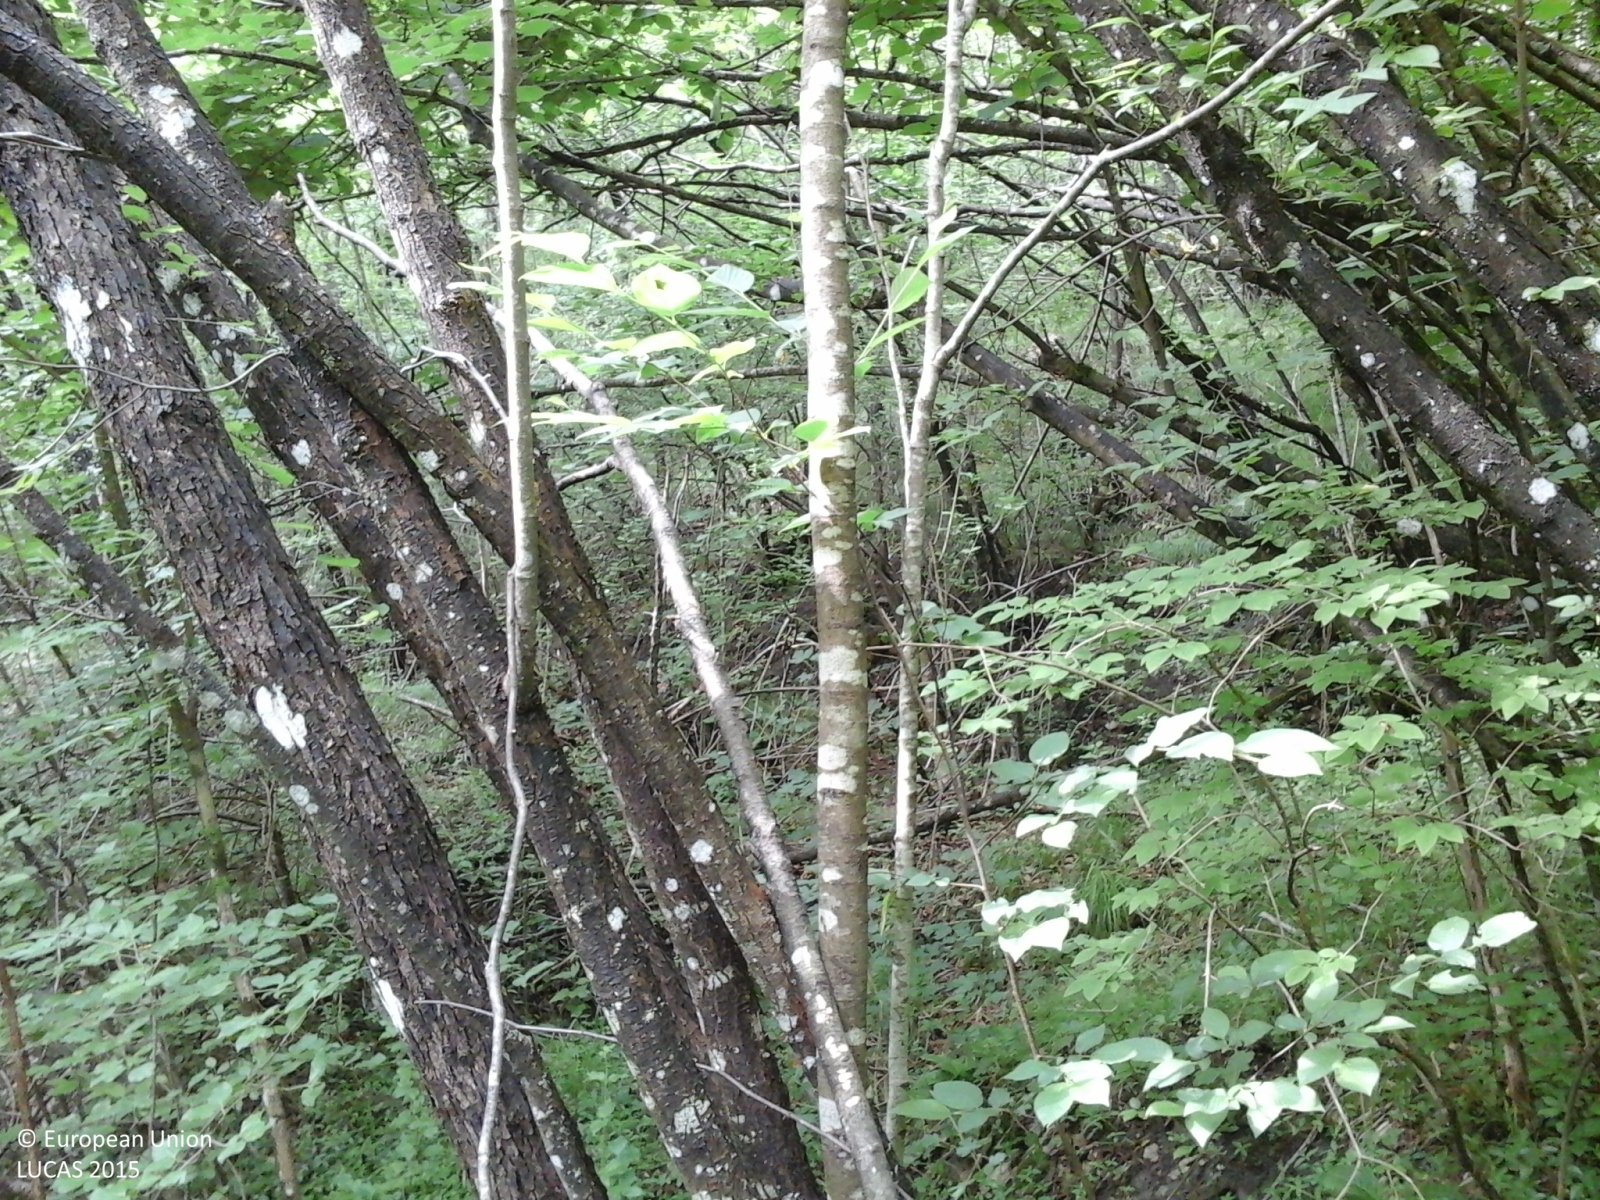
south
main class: Woodland
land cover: Broadleaved woodland
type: thermophilous deciduous forest
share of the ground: > 75 %
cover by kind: broadleaved forest trees 95 %, shrubs 5 %
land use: Forestry
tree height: > 5 m
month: June
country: IT
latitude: 44.7828
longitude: 9.6595
